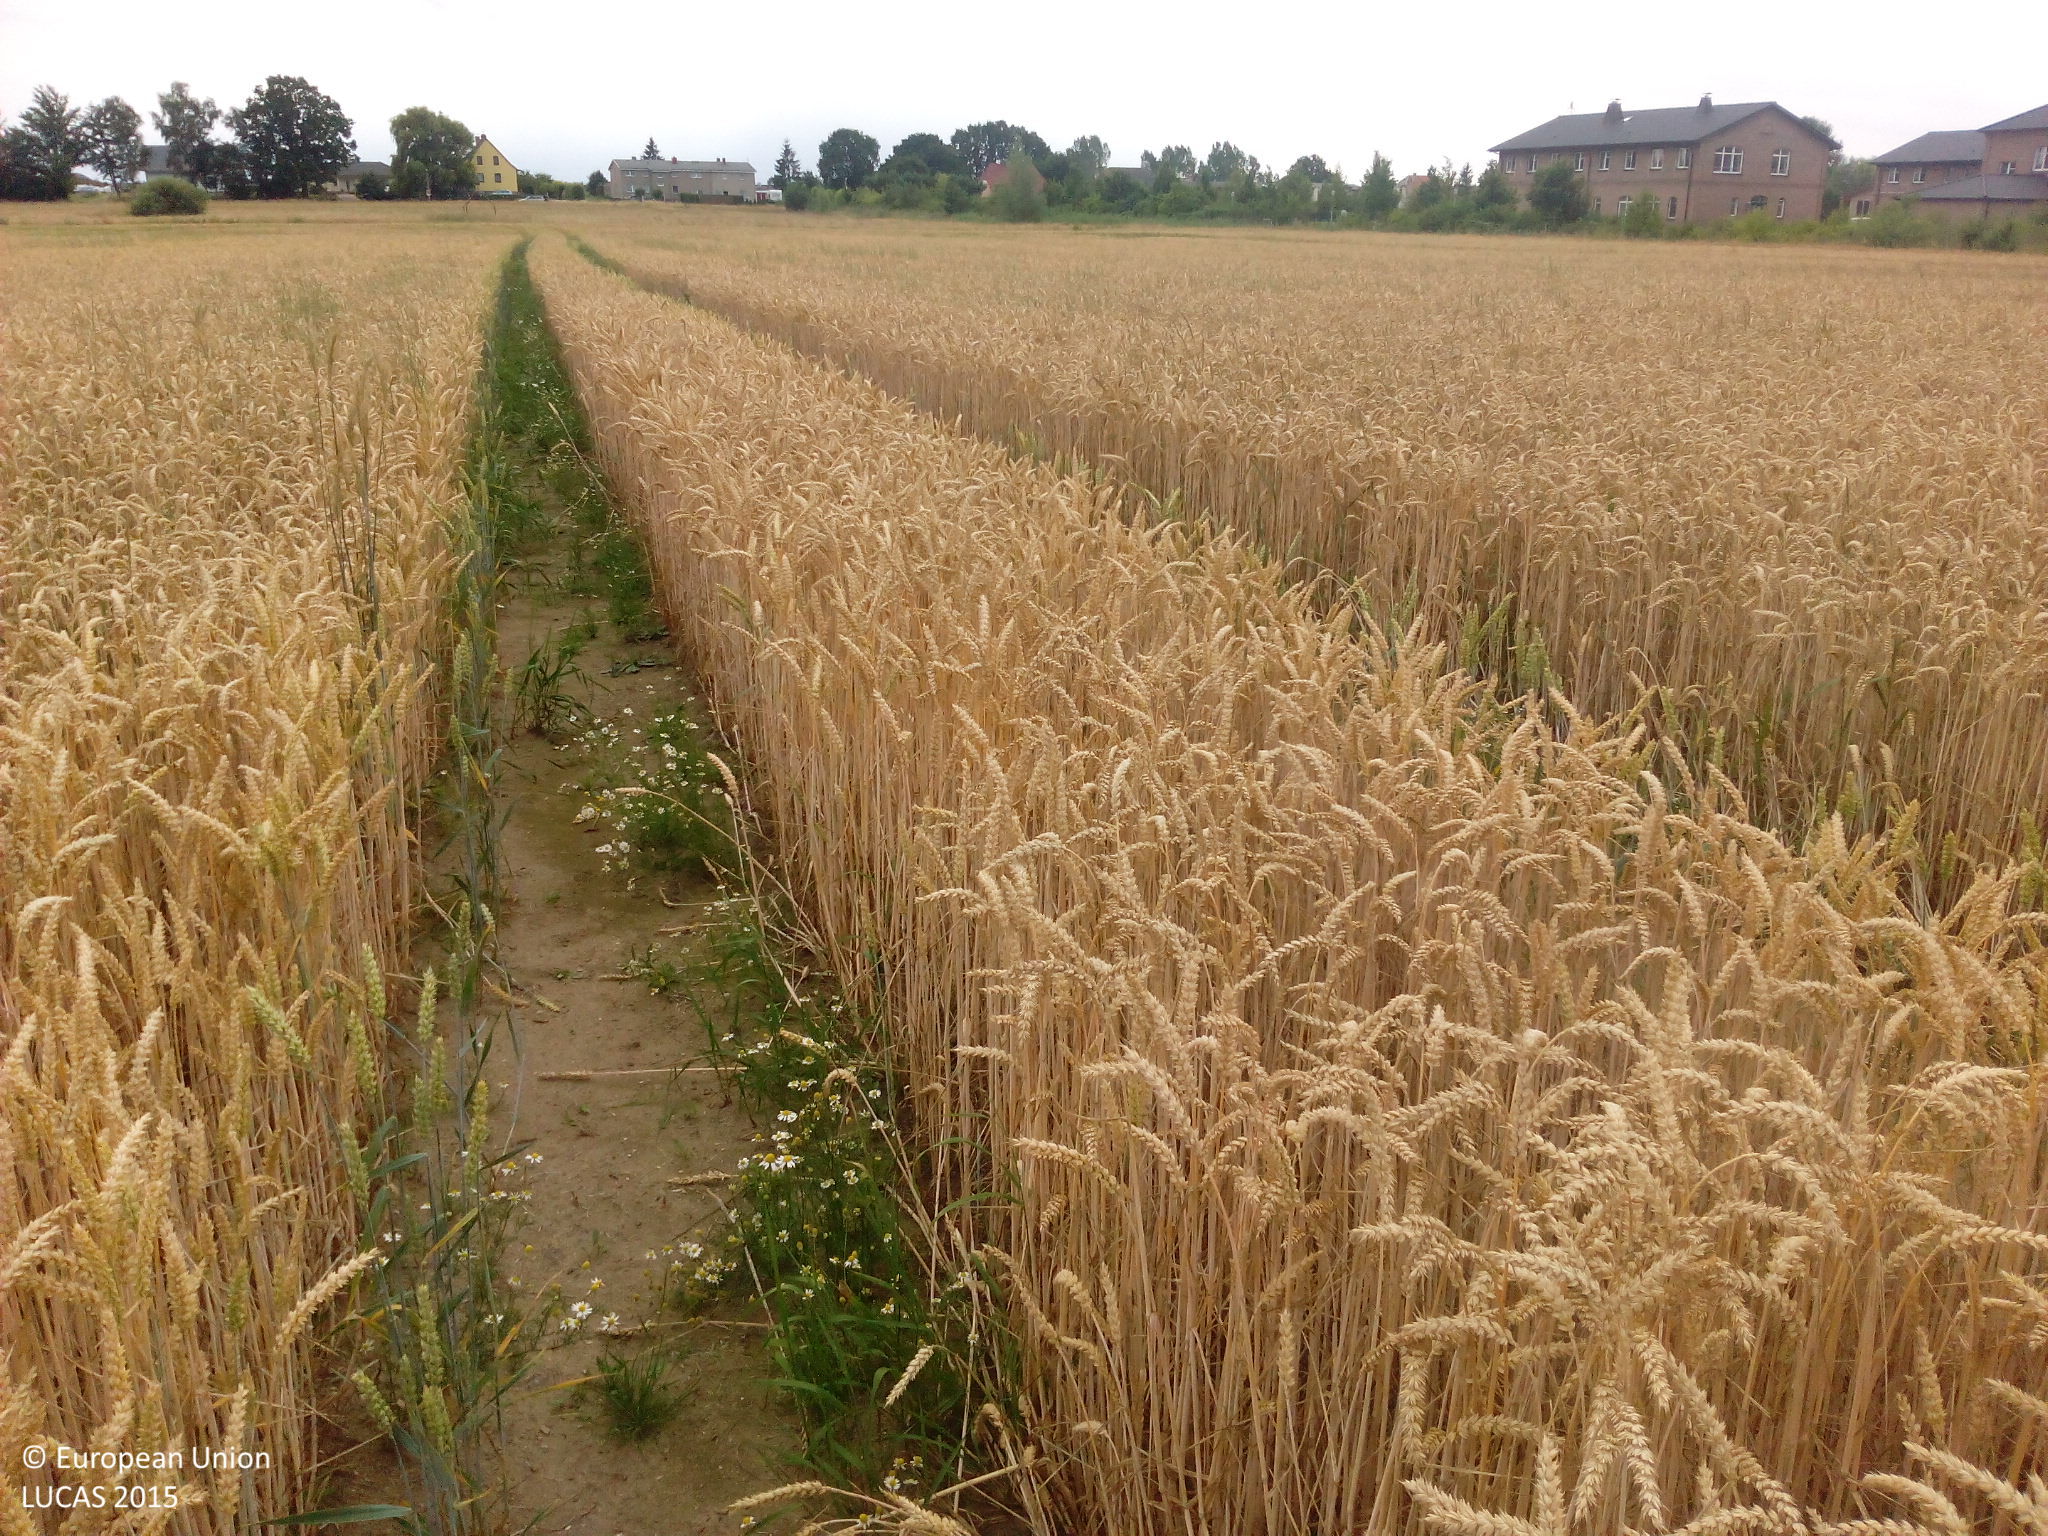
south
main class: Cropland
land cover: Common wheat
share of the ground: > 75 %
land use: Agriculture (excluding fallow land and kitchen gardens)
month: July
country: DE
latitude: 54.2423
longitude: 12.3468
